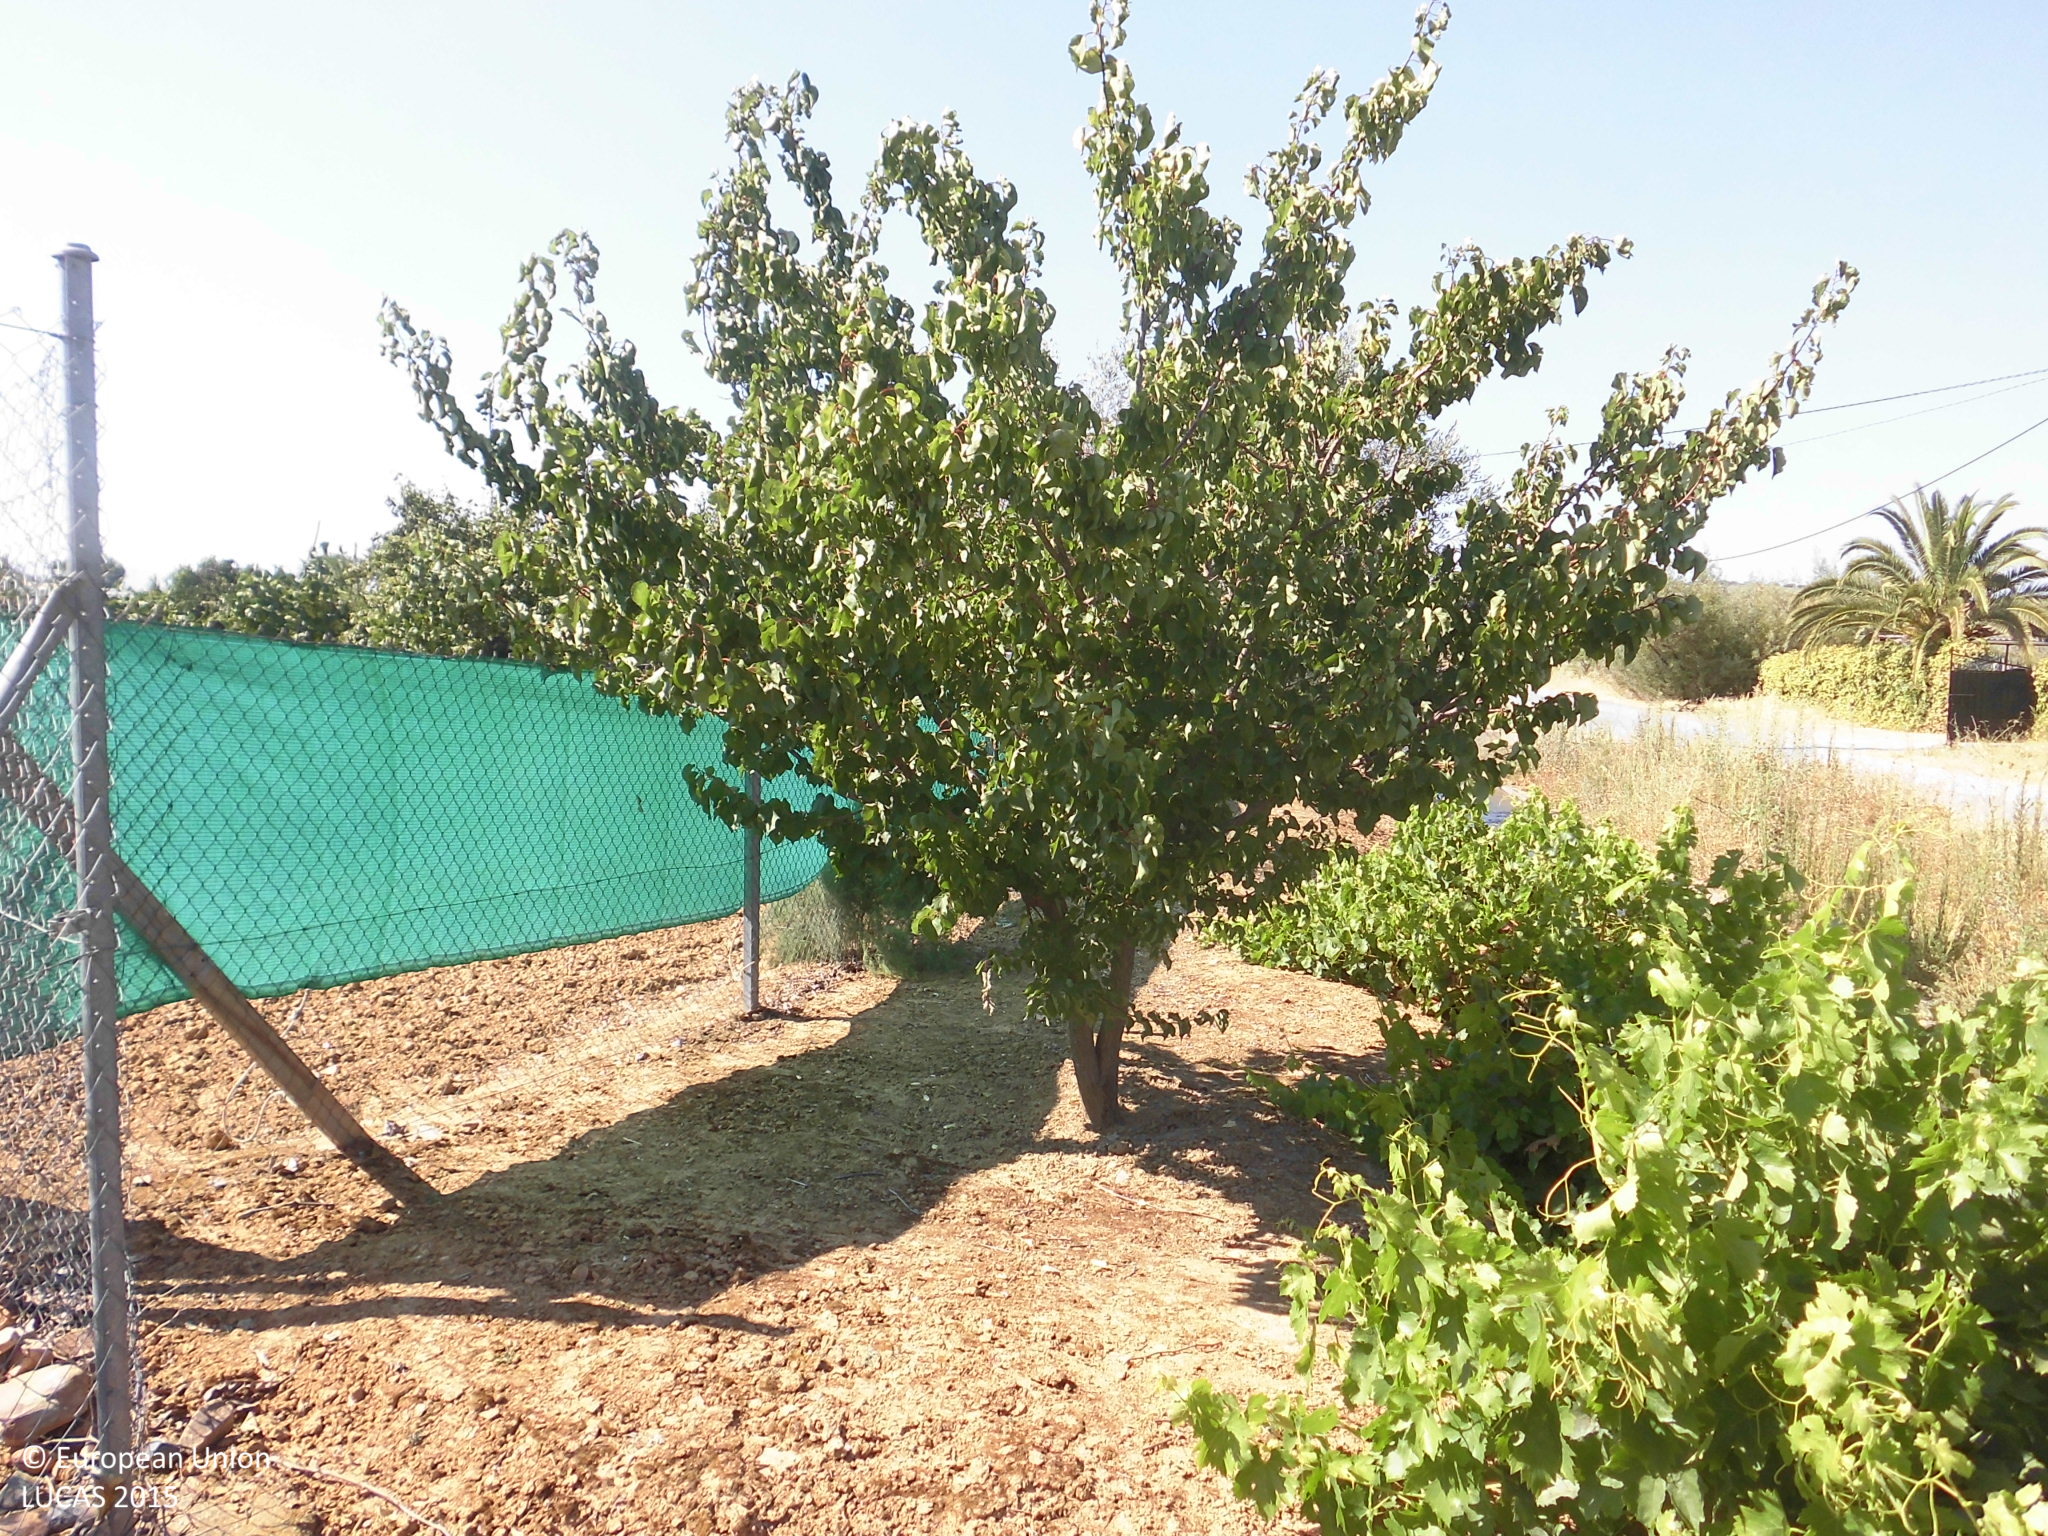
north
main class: Cropland
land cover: Olive groves
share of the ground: < 10 %
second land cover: Other bare soil
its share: > 75 %
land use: Agriculture (excluding fallow land and kitchen gardens)
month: July
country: ES
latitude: 39.9913
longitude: -6.5590
